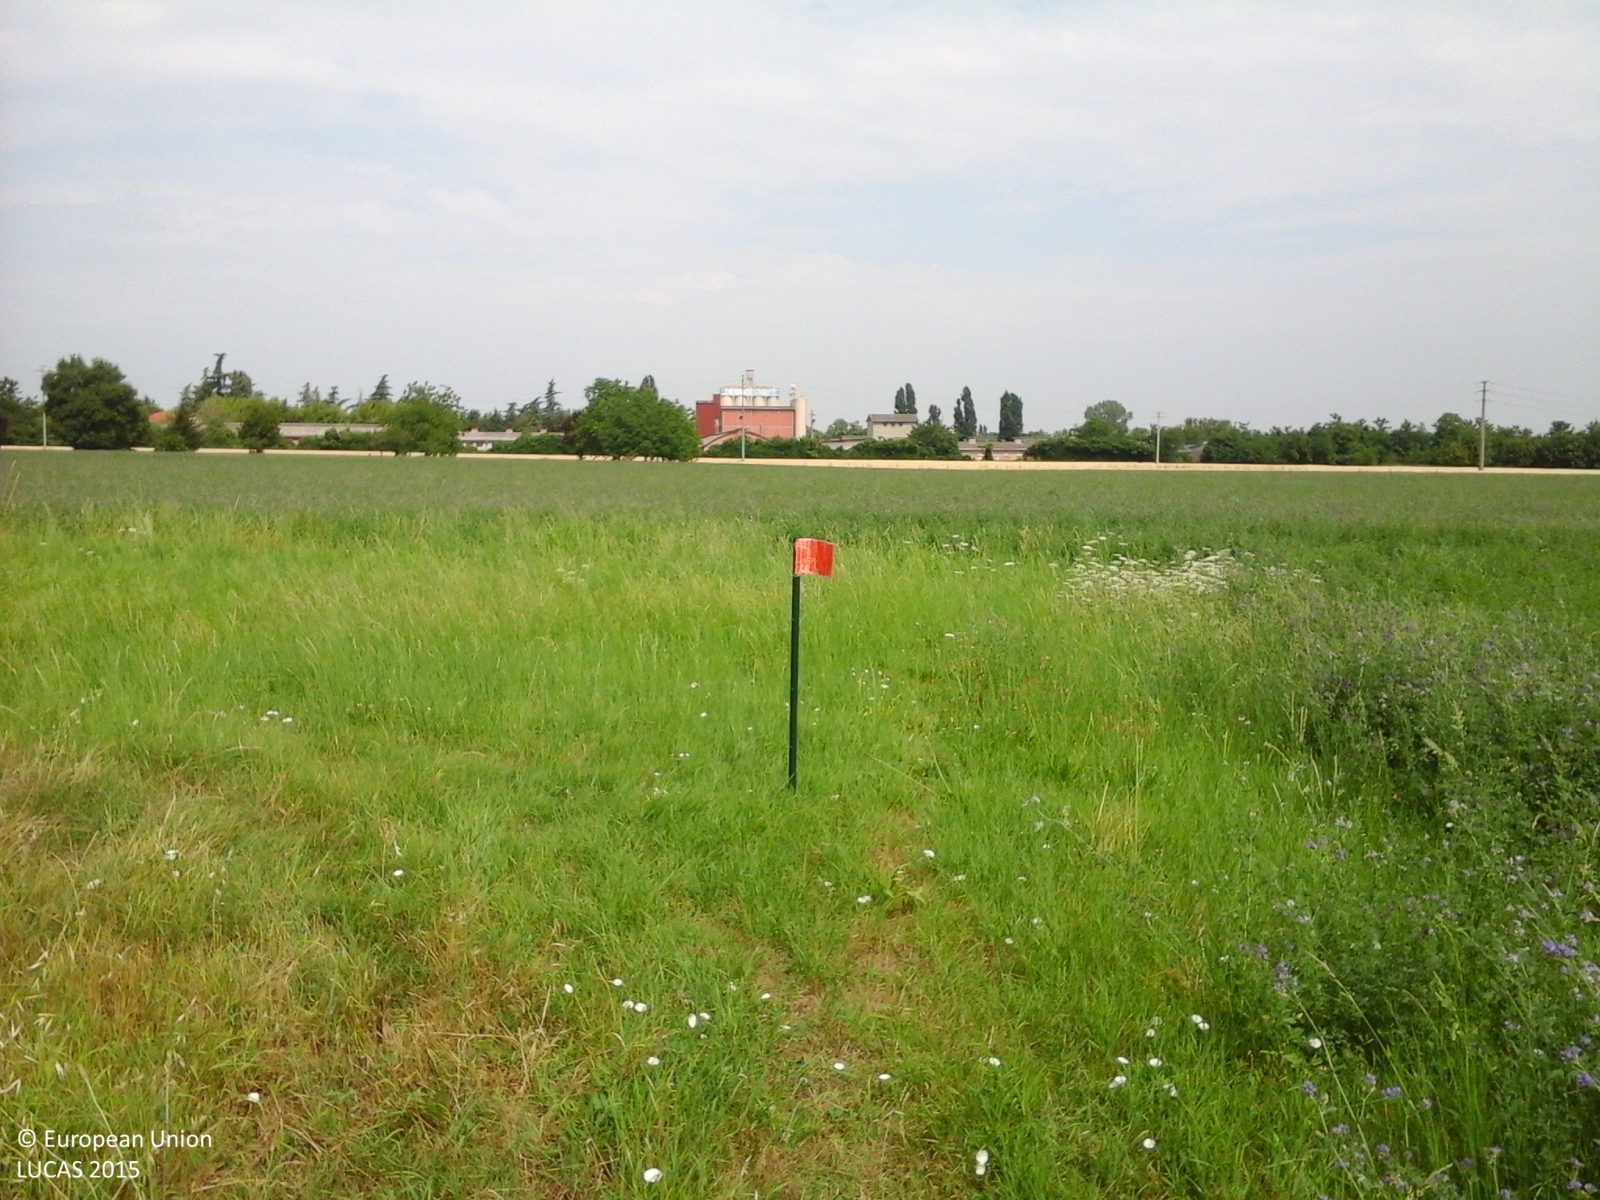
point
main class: Cropland
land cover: Lucerne
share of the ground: > 75 %
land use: Agriculture (excluding fallow land and kitchen gardens)
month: June
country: IT
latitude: 44.6746
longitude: 10.3399
